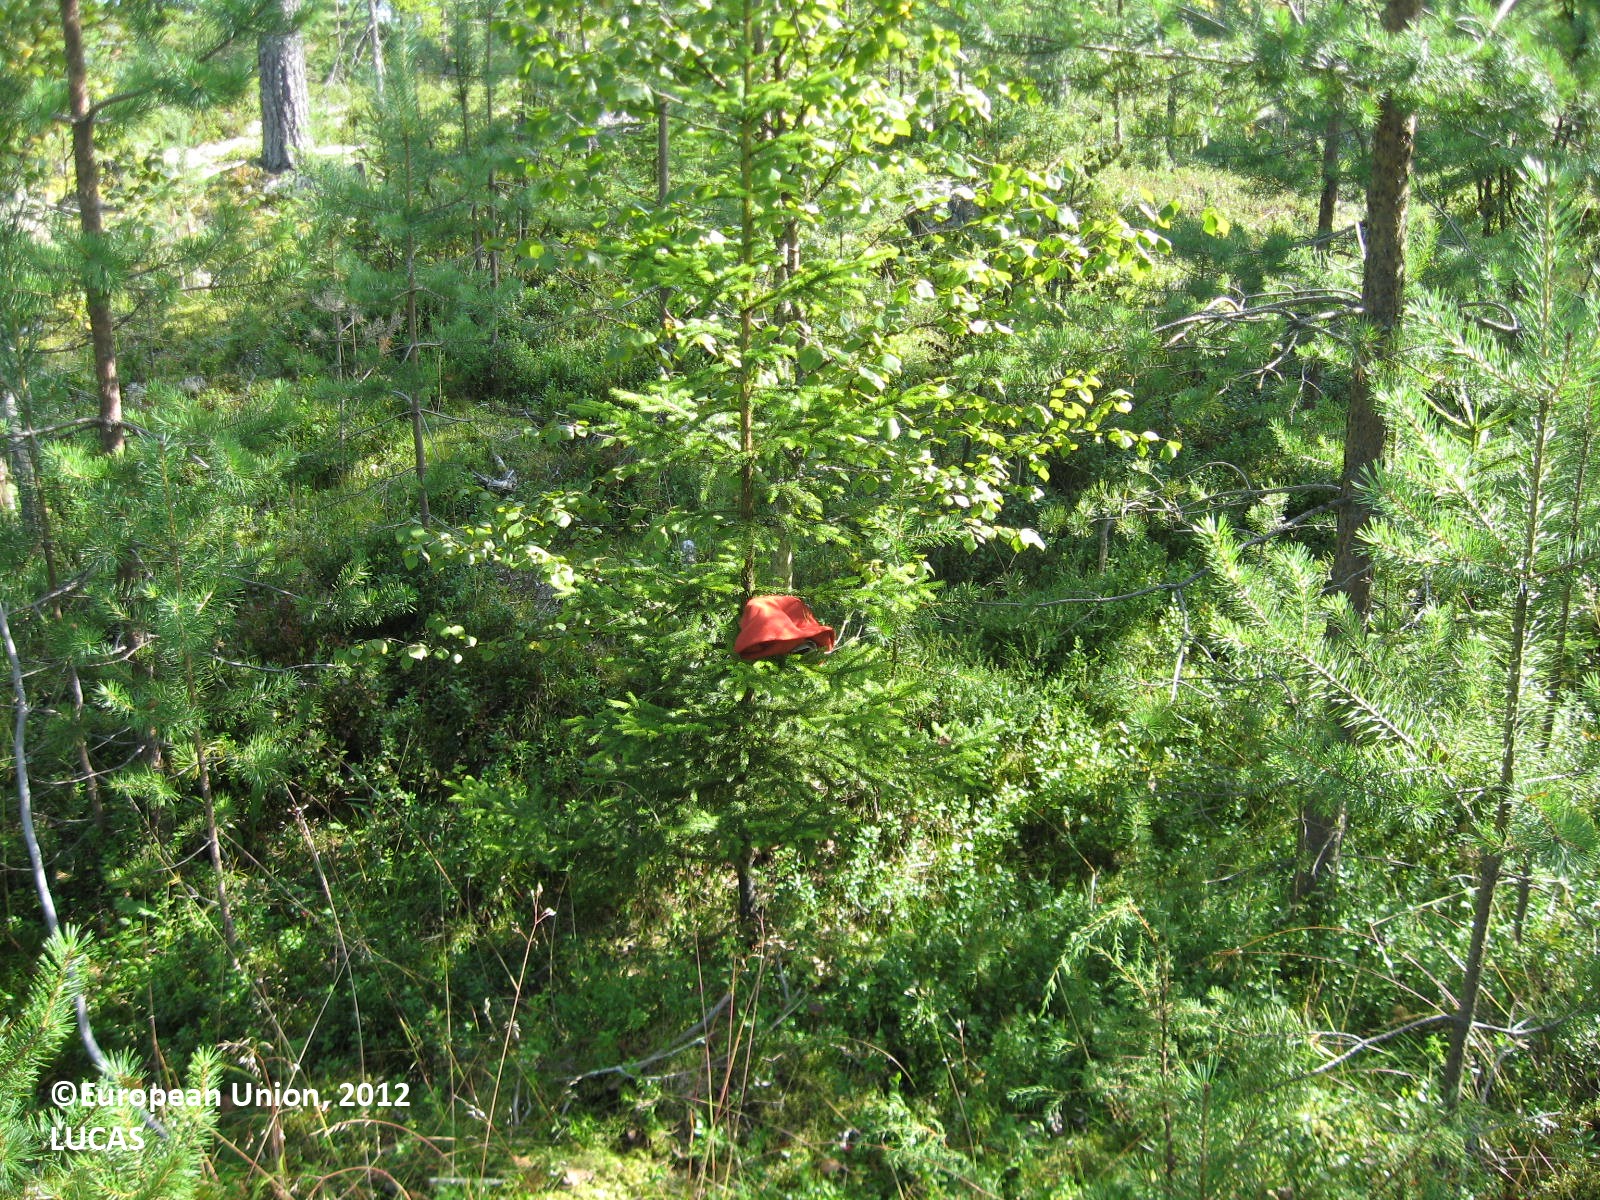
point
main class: Woodland
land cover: Pine dominated mixed woodland
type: boreal forest
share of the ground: > 75 %
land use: Forestry
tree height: > 5 m
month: August
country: FI
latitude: 63.8590
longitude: 28.7679
